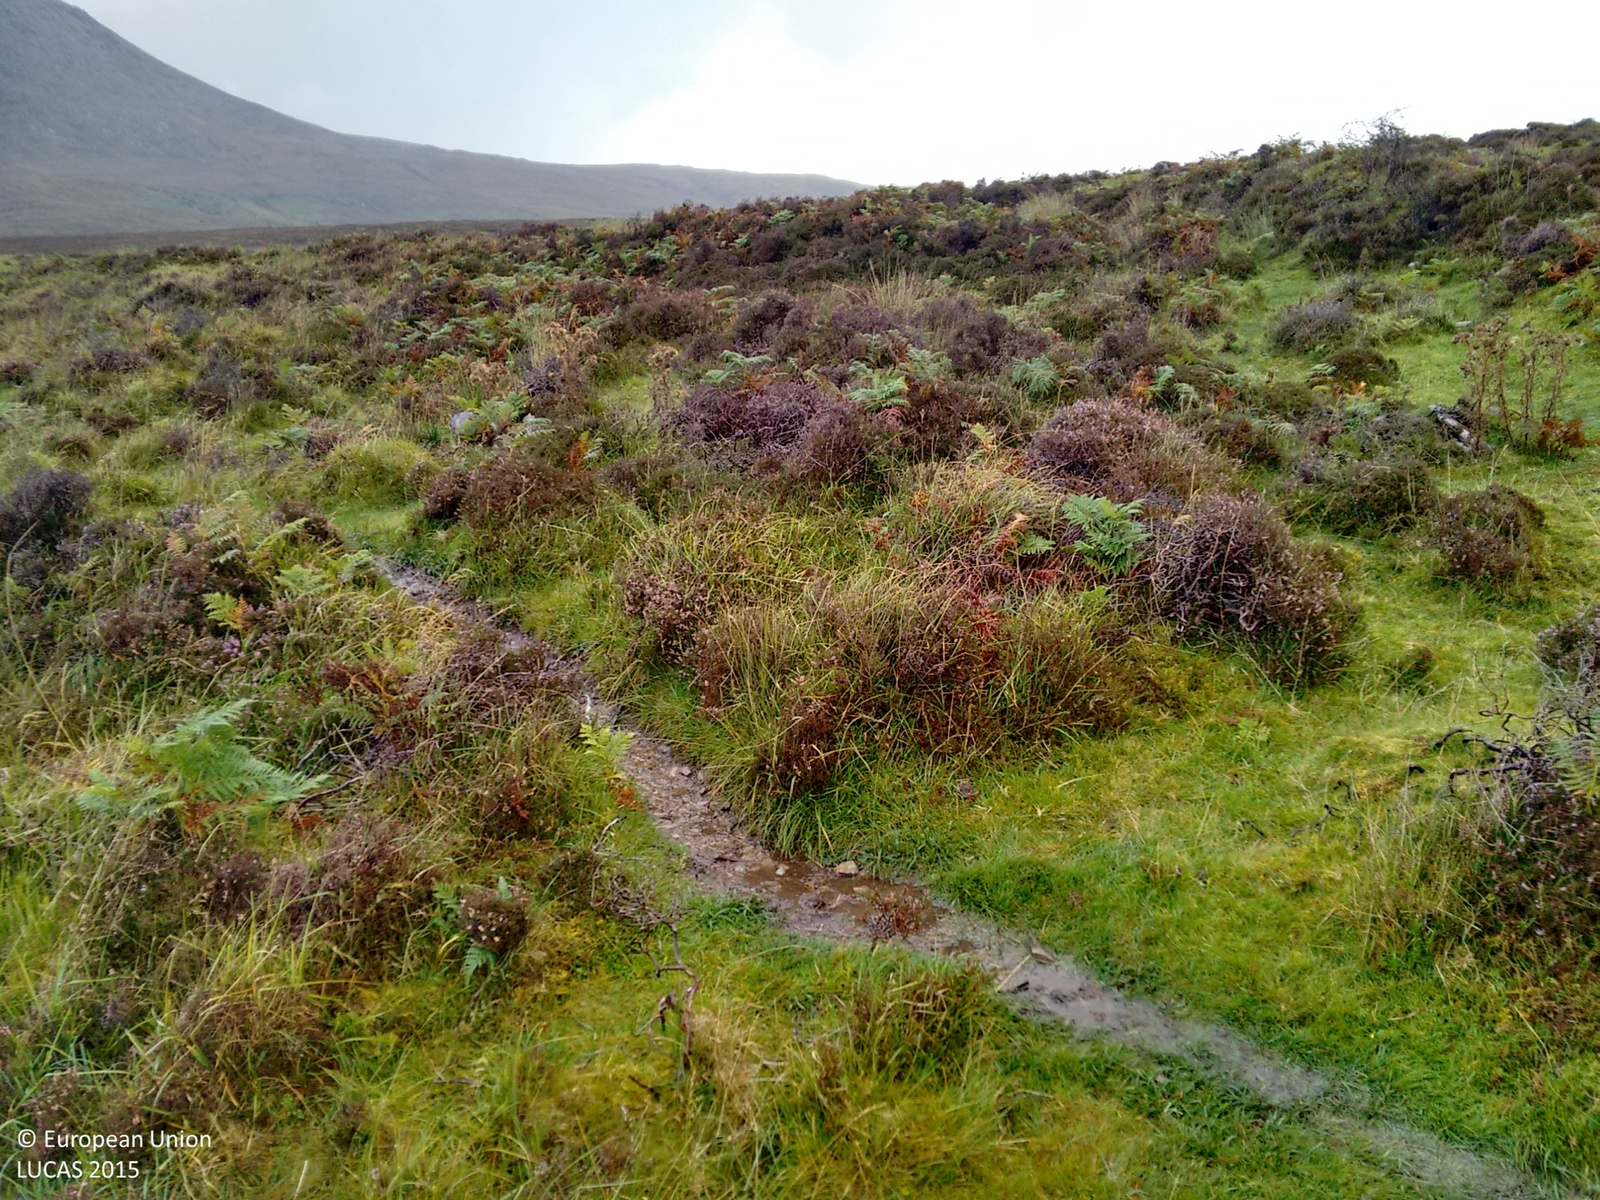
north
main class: Shrubland
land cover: Shrubland without tree cover
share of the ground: > 75 %
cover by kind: shrubs 75 %, herbaceous plants 25 %
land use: Agriculture (excluding fallow land and kitchen gardens)
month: September
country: GB
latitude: 57.2214
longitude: -5.9443
